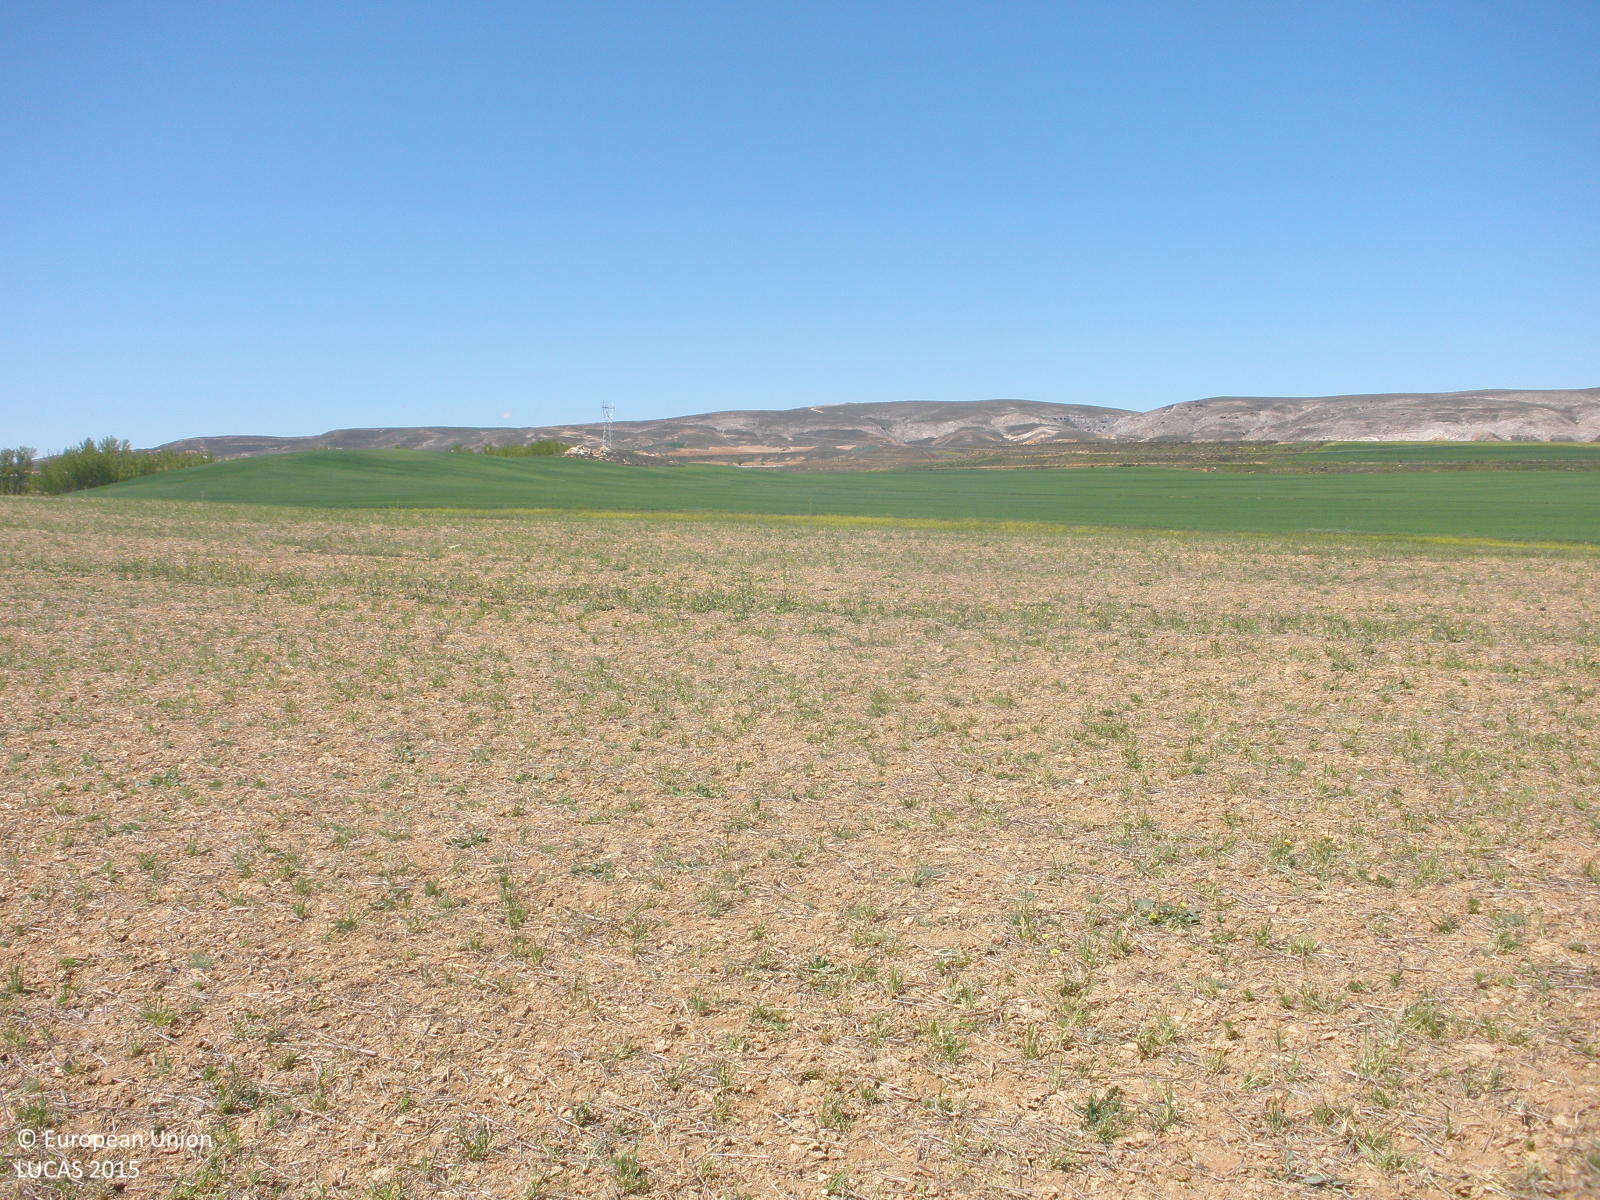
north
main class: Grassland
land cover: Spontaneously vegetated surfaces
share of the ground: 25 - 50 %
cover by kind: unconsolidated bare surface 60 %, herbaceous plants 40 %
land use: Agriculture (excluding fallow land and kitchen gardens)
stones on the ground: < 10 %
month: May
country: ES
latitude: 40.6887
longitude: -0.8157
